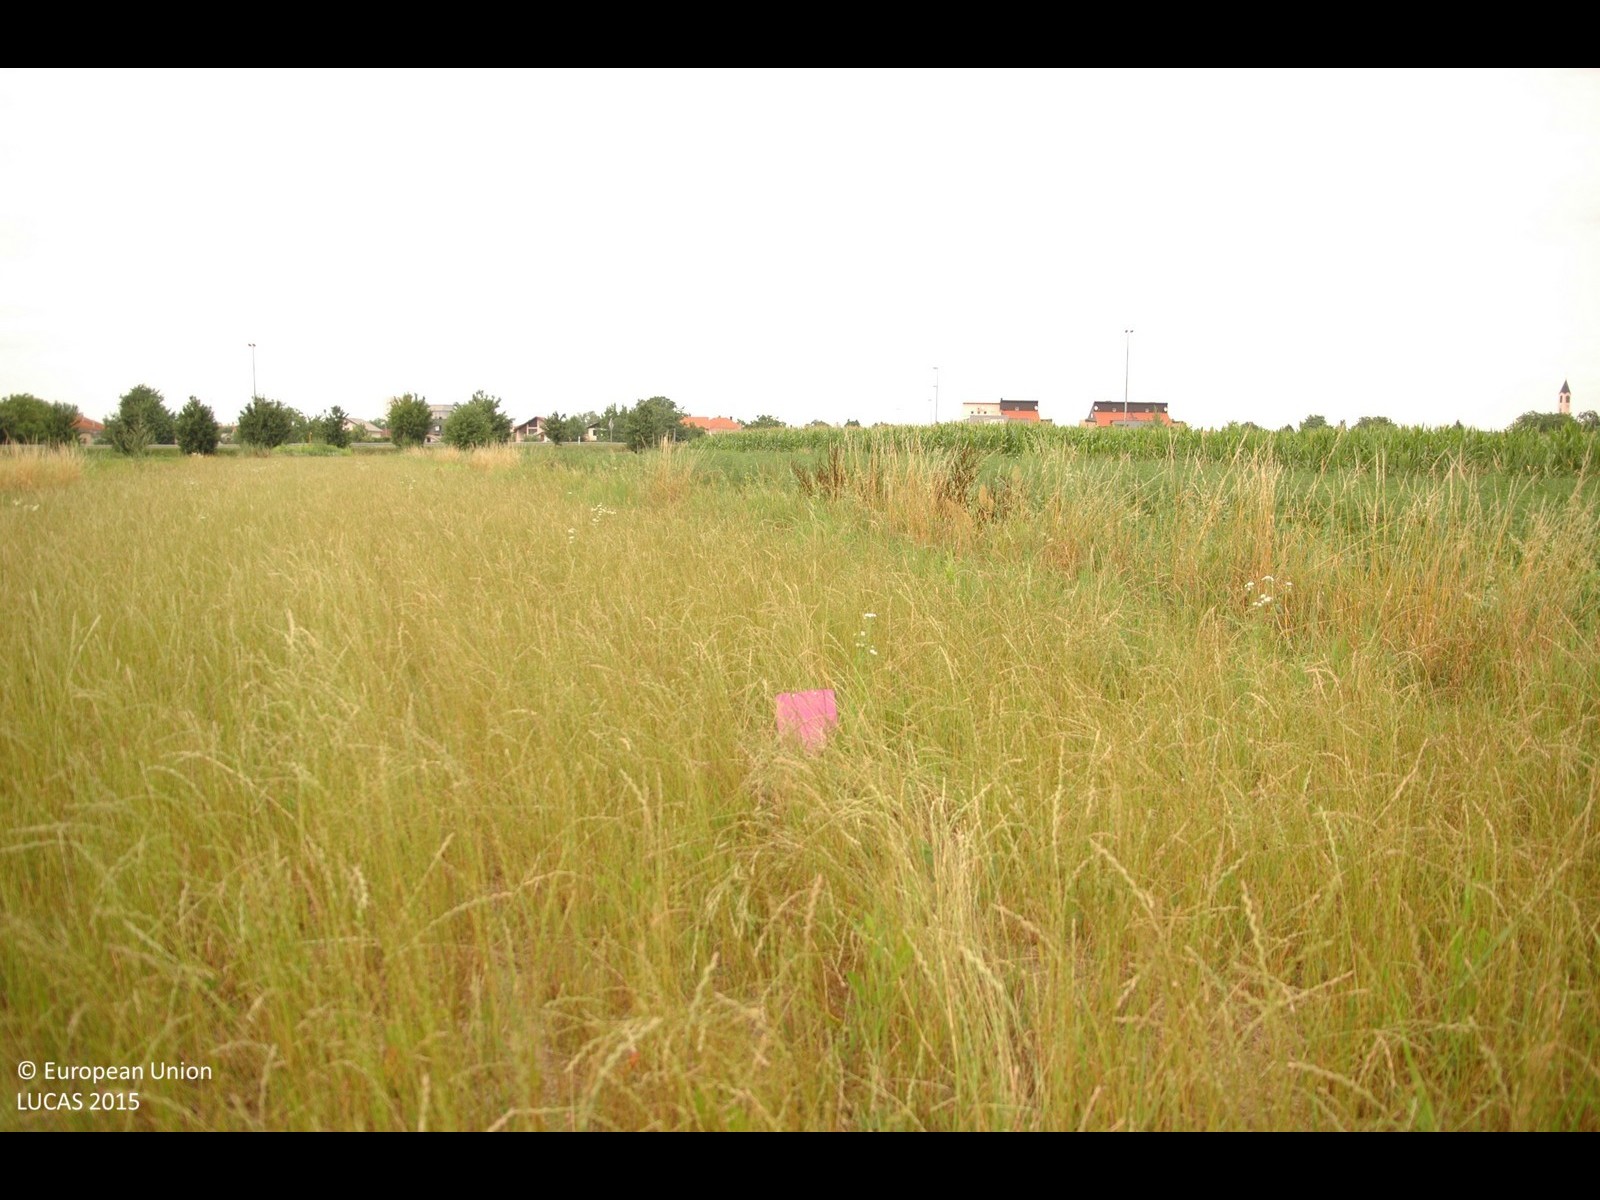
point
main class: Grassland
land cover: Grassland without tree/shrub cover
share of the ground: > 75 %
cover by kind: herbaceous plants 100 %
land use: Agriculture (excluding fallow land and kitchen gardens)
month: July
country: HR
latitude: 46.3741
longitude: 16.4357
